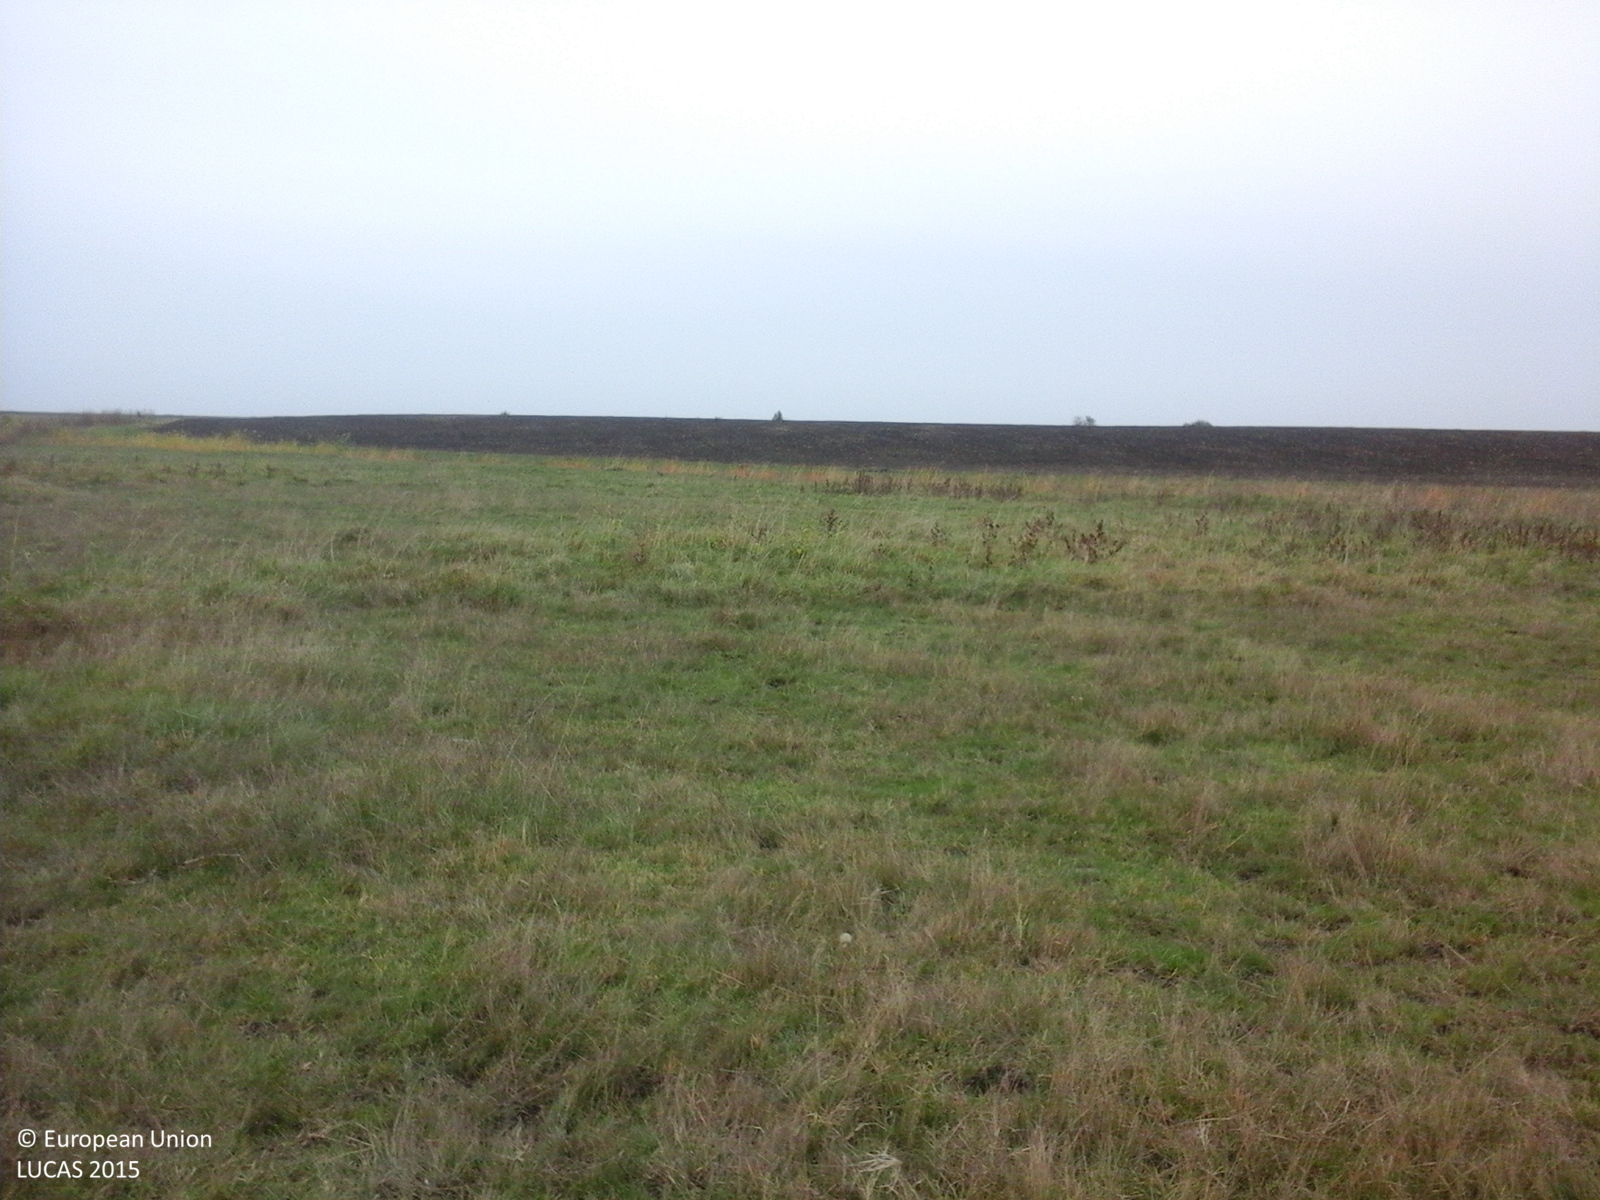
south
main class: Grassland
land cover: Grassland without tree/shrub cover
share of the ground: > 75 %
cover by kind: herbaceous plants 100 %
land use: Agriculture (excluding fallow land and kitchen gardens)
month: October
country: RO
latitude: 44.9141
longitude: 26.3682
